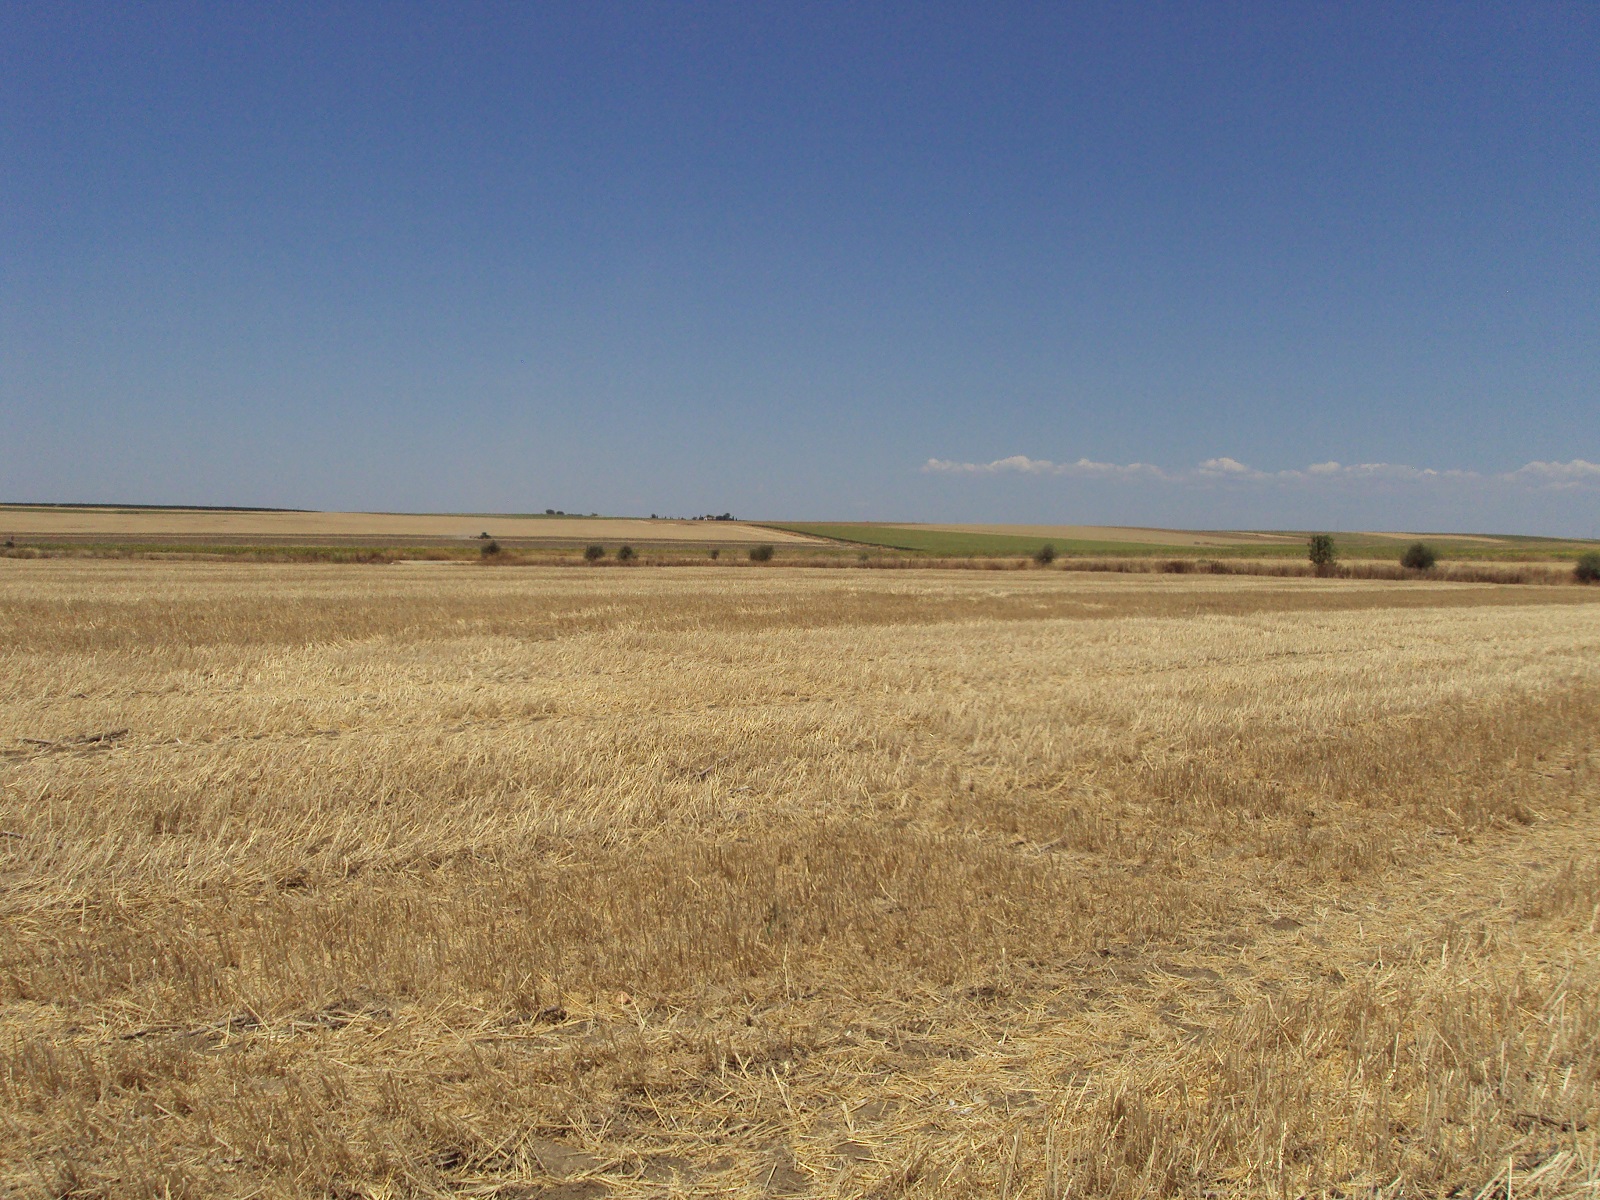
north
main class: Cropland
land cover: Durum wheat
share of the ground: > 75 %
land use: Agriculture (excluding fallow land and kitchen gardens)
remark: Harvested field
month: June
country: ES
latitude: 37.3333
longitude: -6.8893
